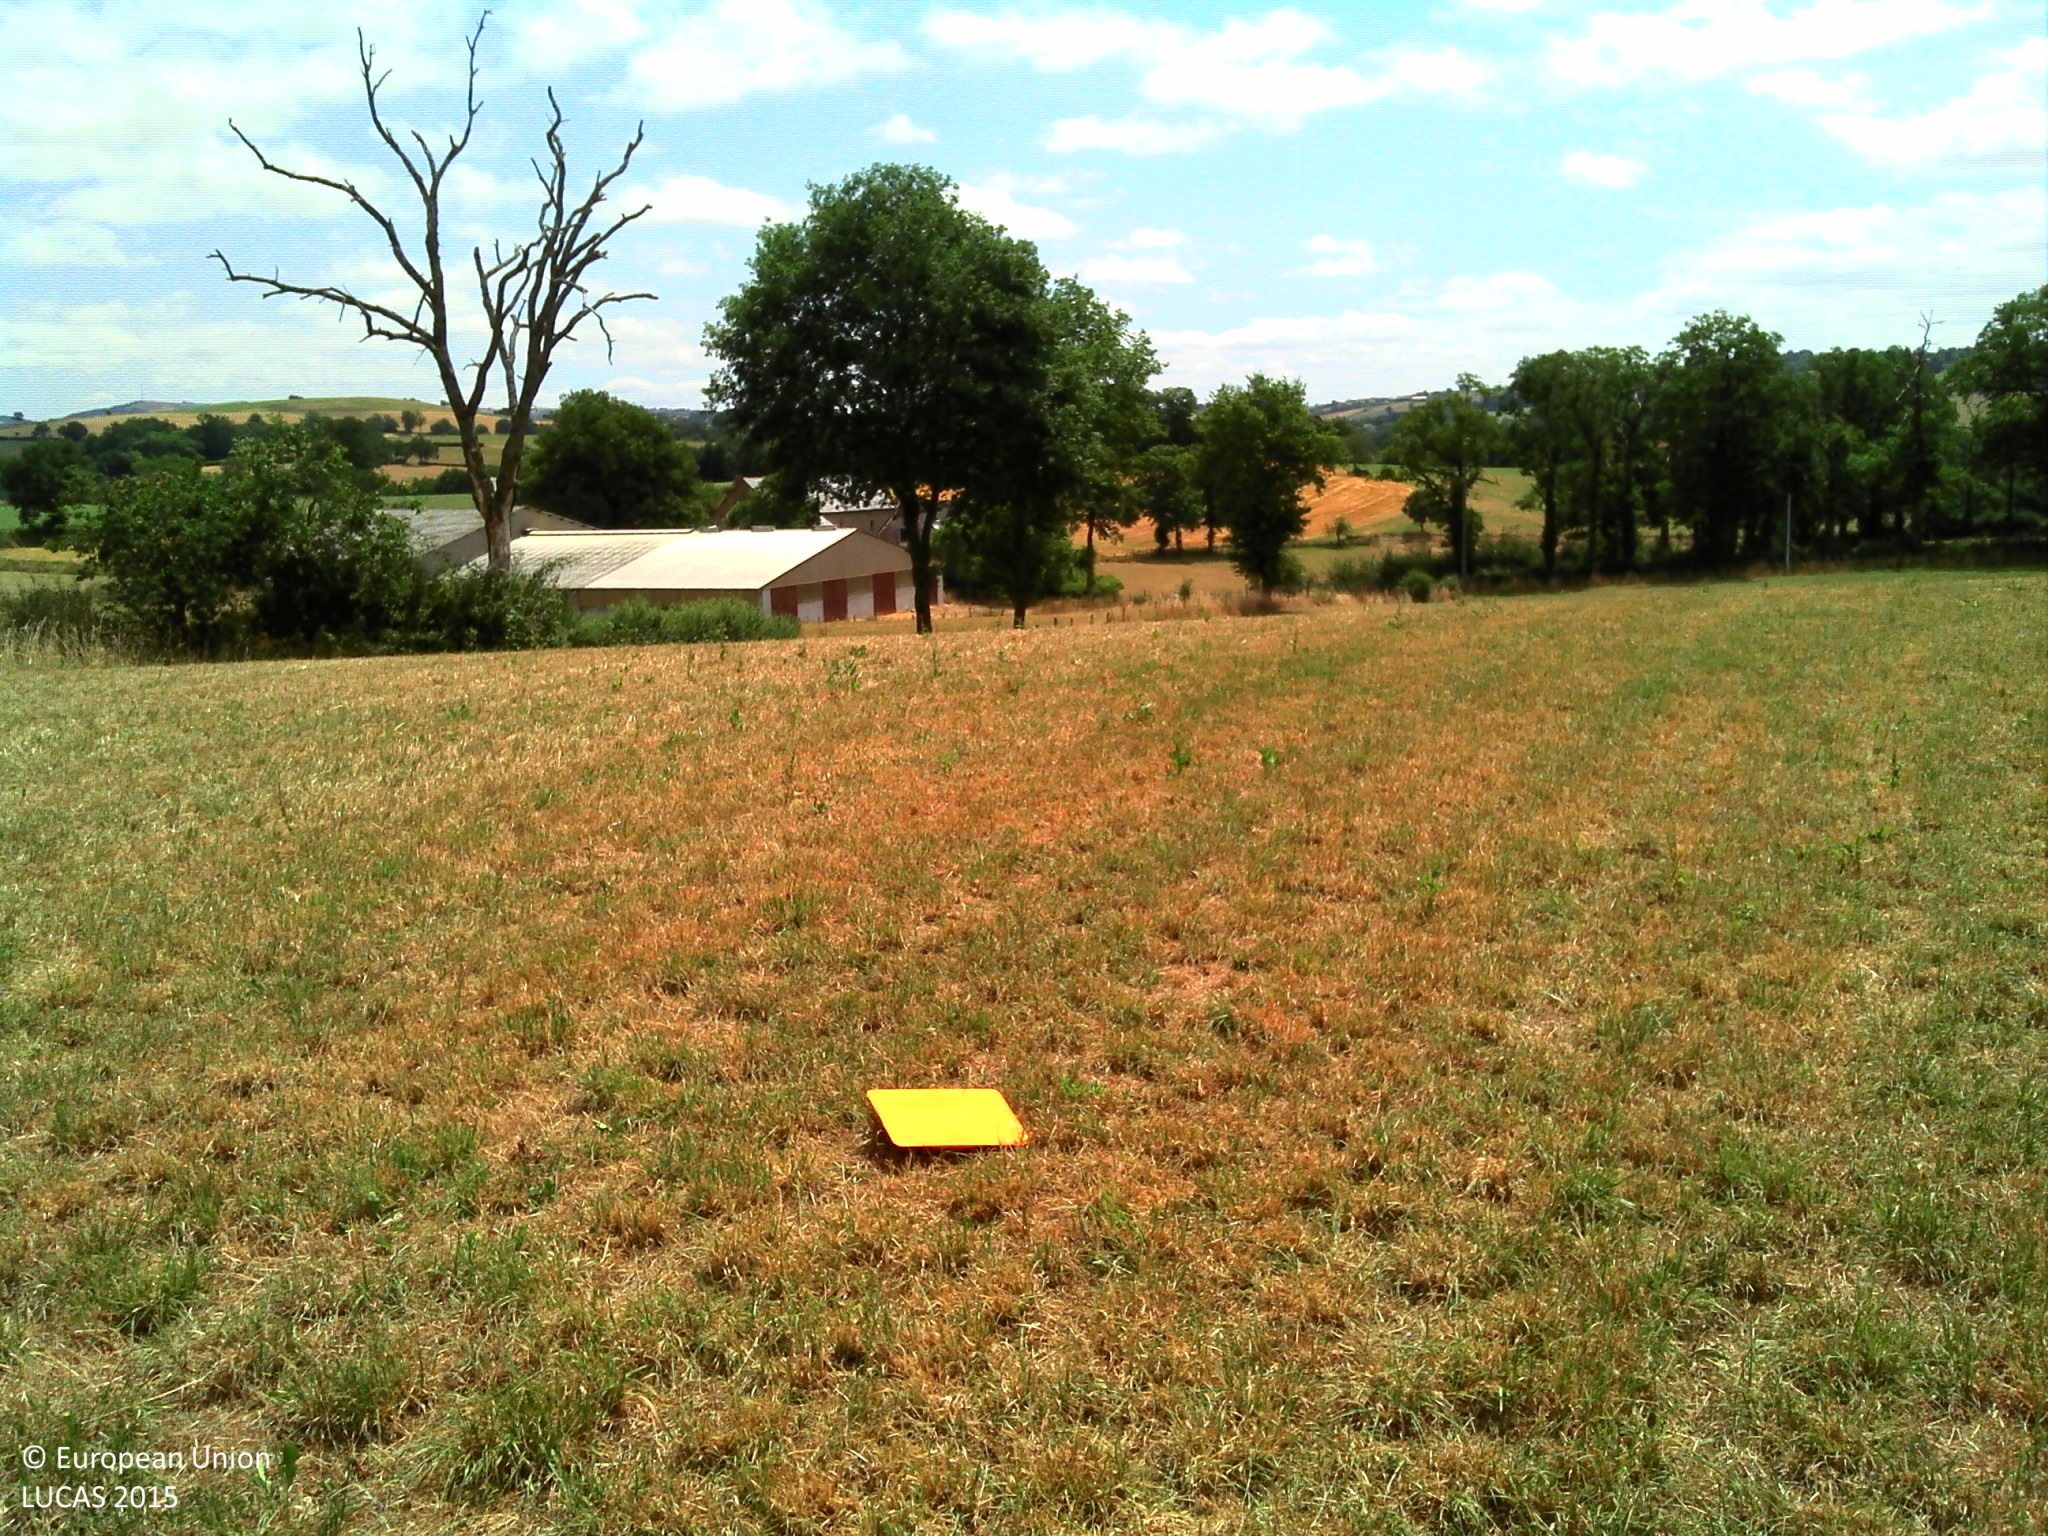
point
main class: Cropland
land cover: Temporary grasslands
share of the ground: > 75 %
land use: Agriculture (excluding fallow land and kitchen gardens)
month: July
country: FR
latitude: 44.1165
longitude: 2.5195
